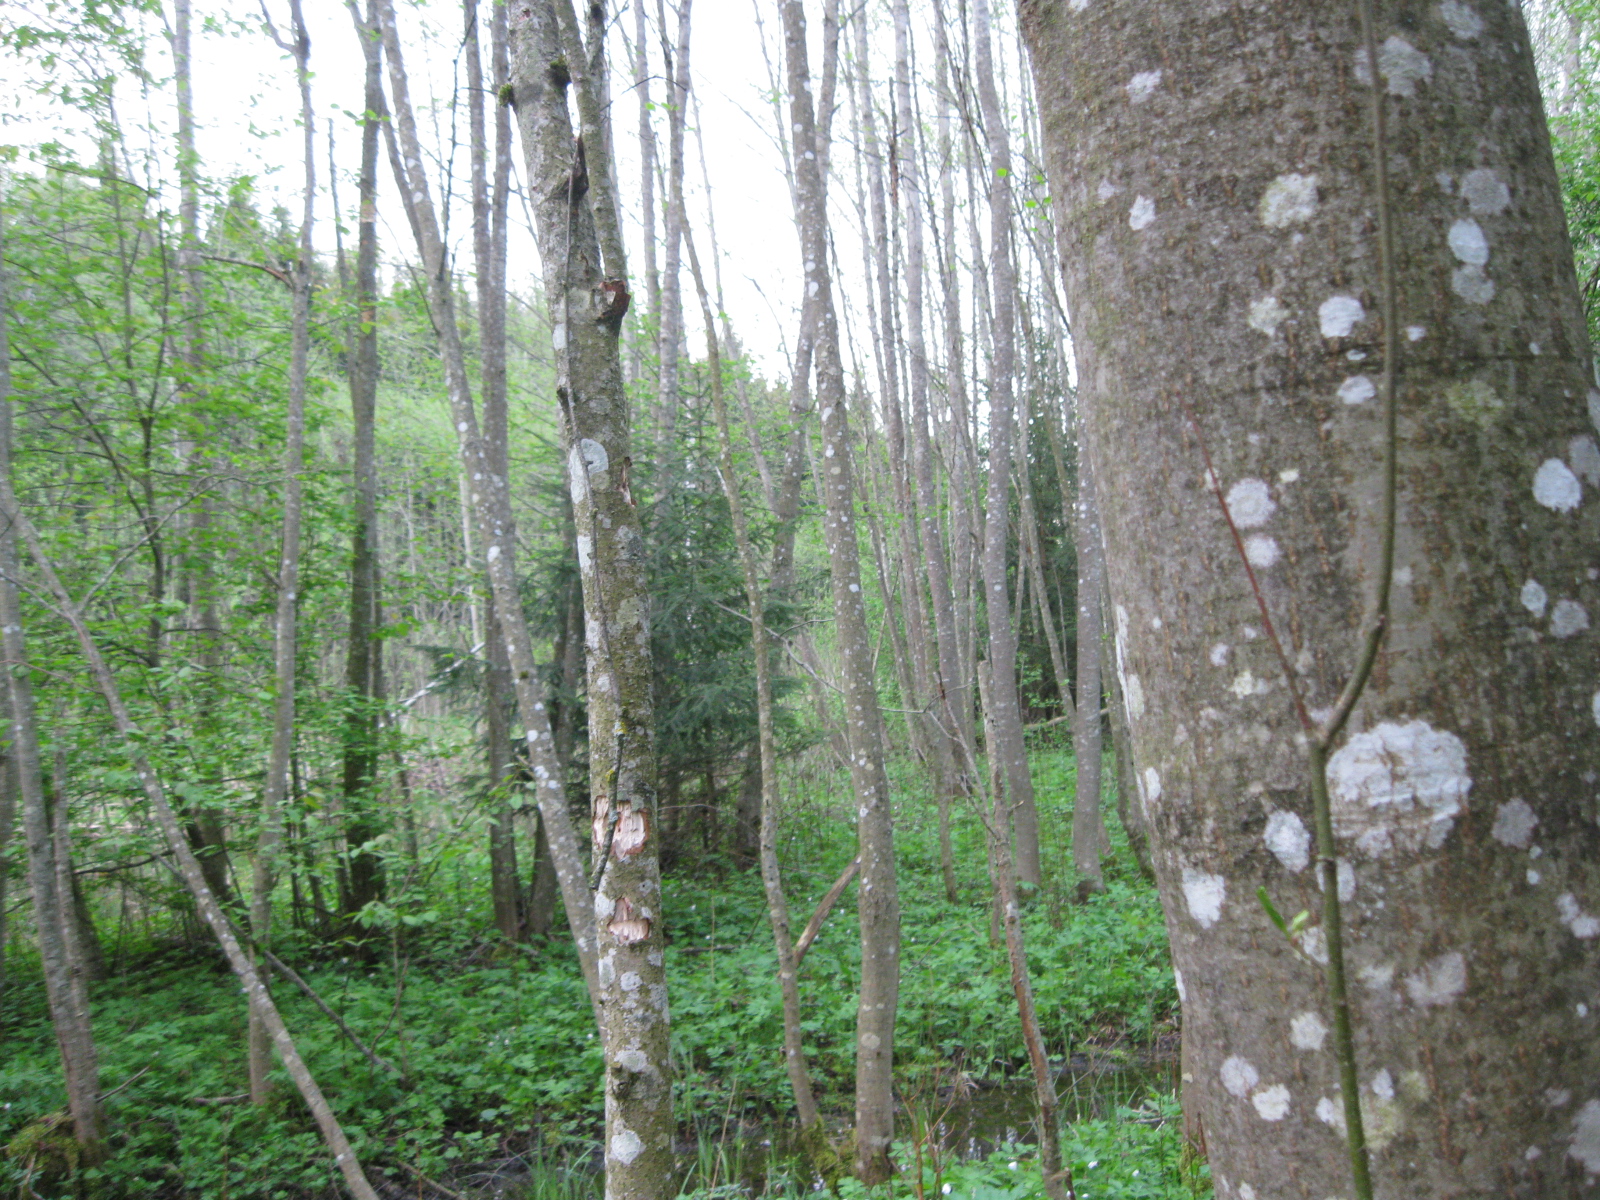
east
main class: Woodland
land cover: Broadleaved woodland
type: non-riverine alder, birch or aspen forest
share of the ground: > 75 %
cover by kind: broadleaved forest trees 85 %, herbaceous plants 10 %, lichens and mosses 5 %
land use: Forestry
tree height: > 5 m
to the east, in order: Broadleaved woodland; Electric lines; Broadleaved woodland; Spruce dominated coniferous woodland; Broadleaved woodland; Spruce dominated coniferous woodland; Broadleaved woodland
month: May
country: LT
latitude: 56.2221
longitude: 24.4660
